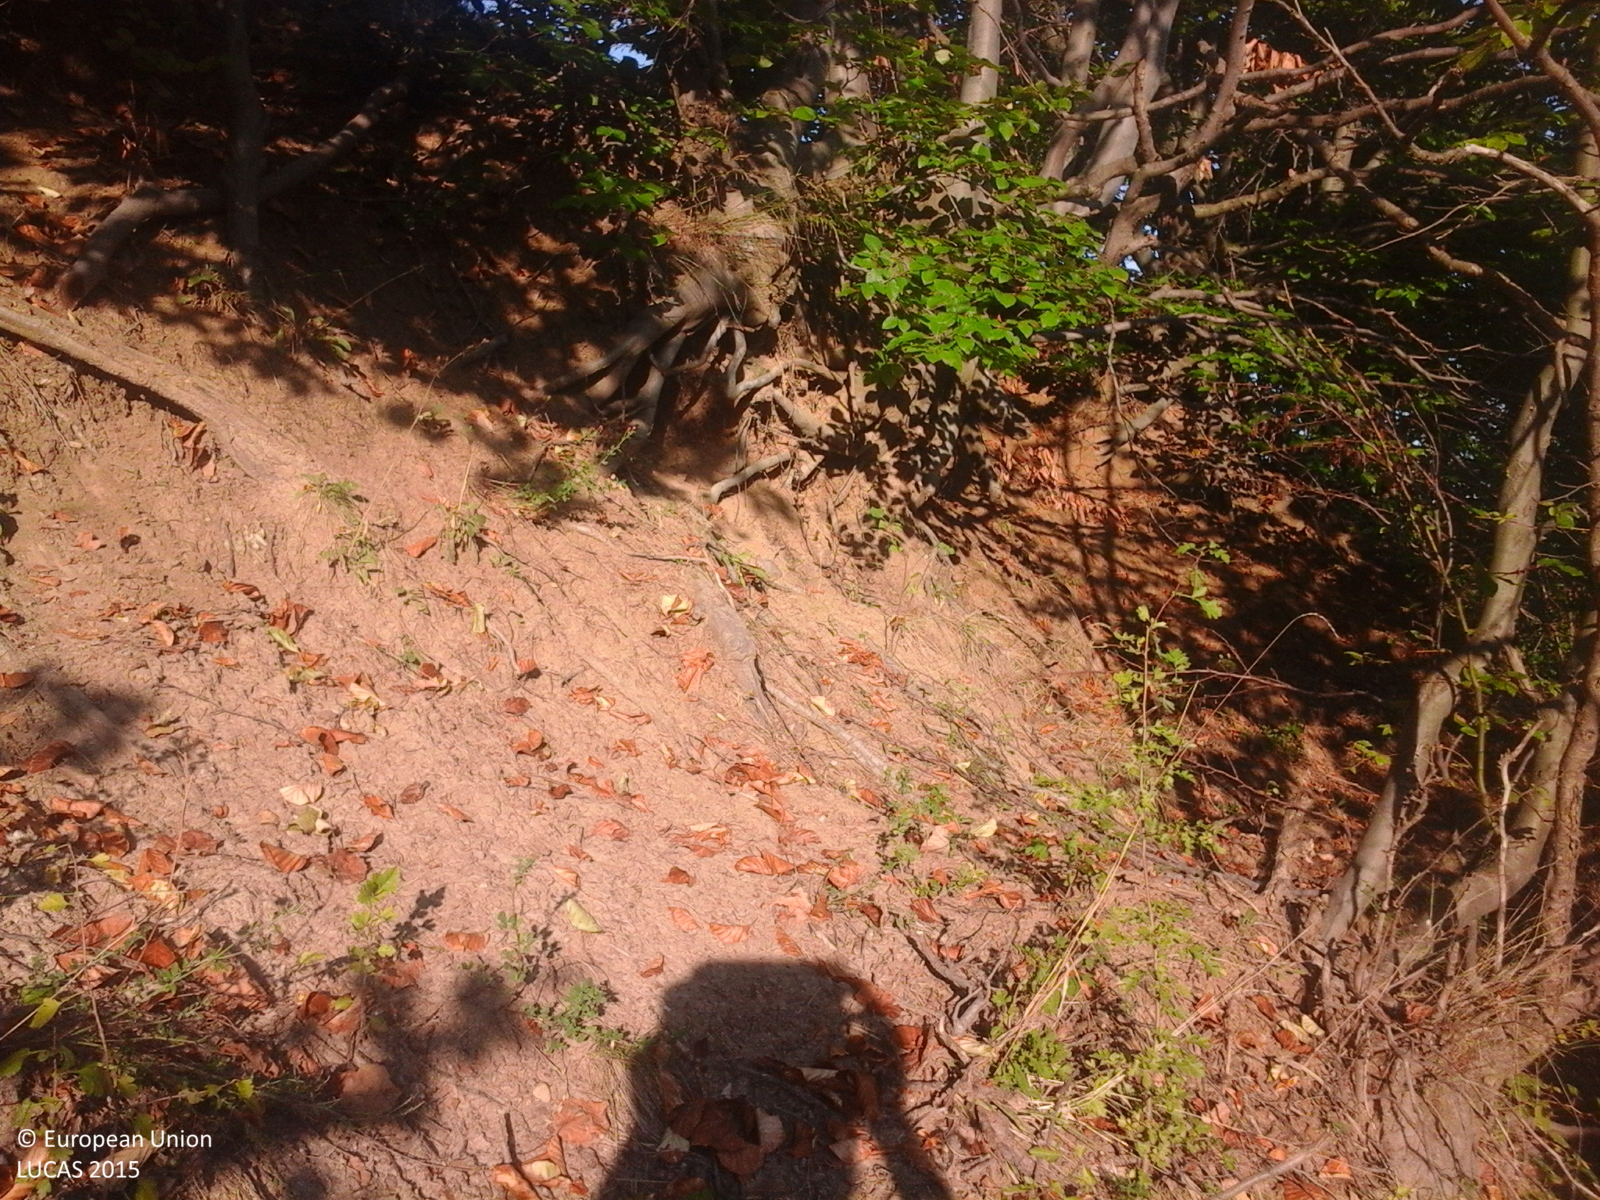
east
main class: Woodland
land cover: Broadleaved woodland
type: beech forest
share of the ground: > 75 %
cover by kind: broadleaved forest trees 100 %
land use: Forestry
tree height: > 5 m
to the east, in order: Broadleaved woodland; Grassland with sparse tree/shrub cover; Grassland without tree/shrub cover; Inland marshes; Rocks and stones; Grassland without tree/shrub cover
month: August
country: RO
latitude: 46.3068
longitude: 26.8531
